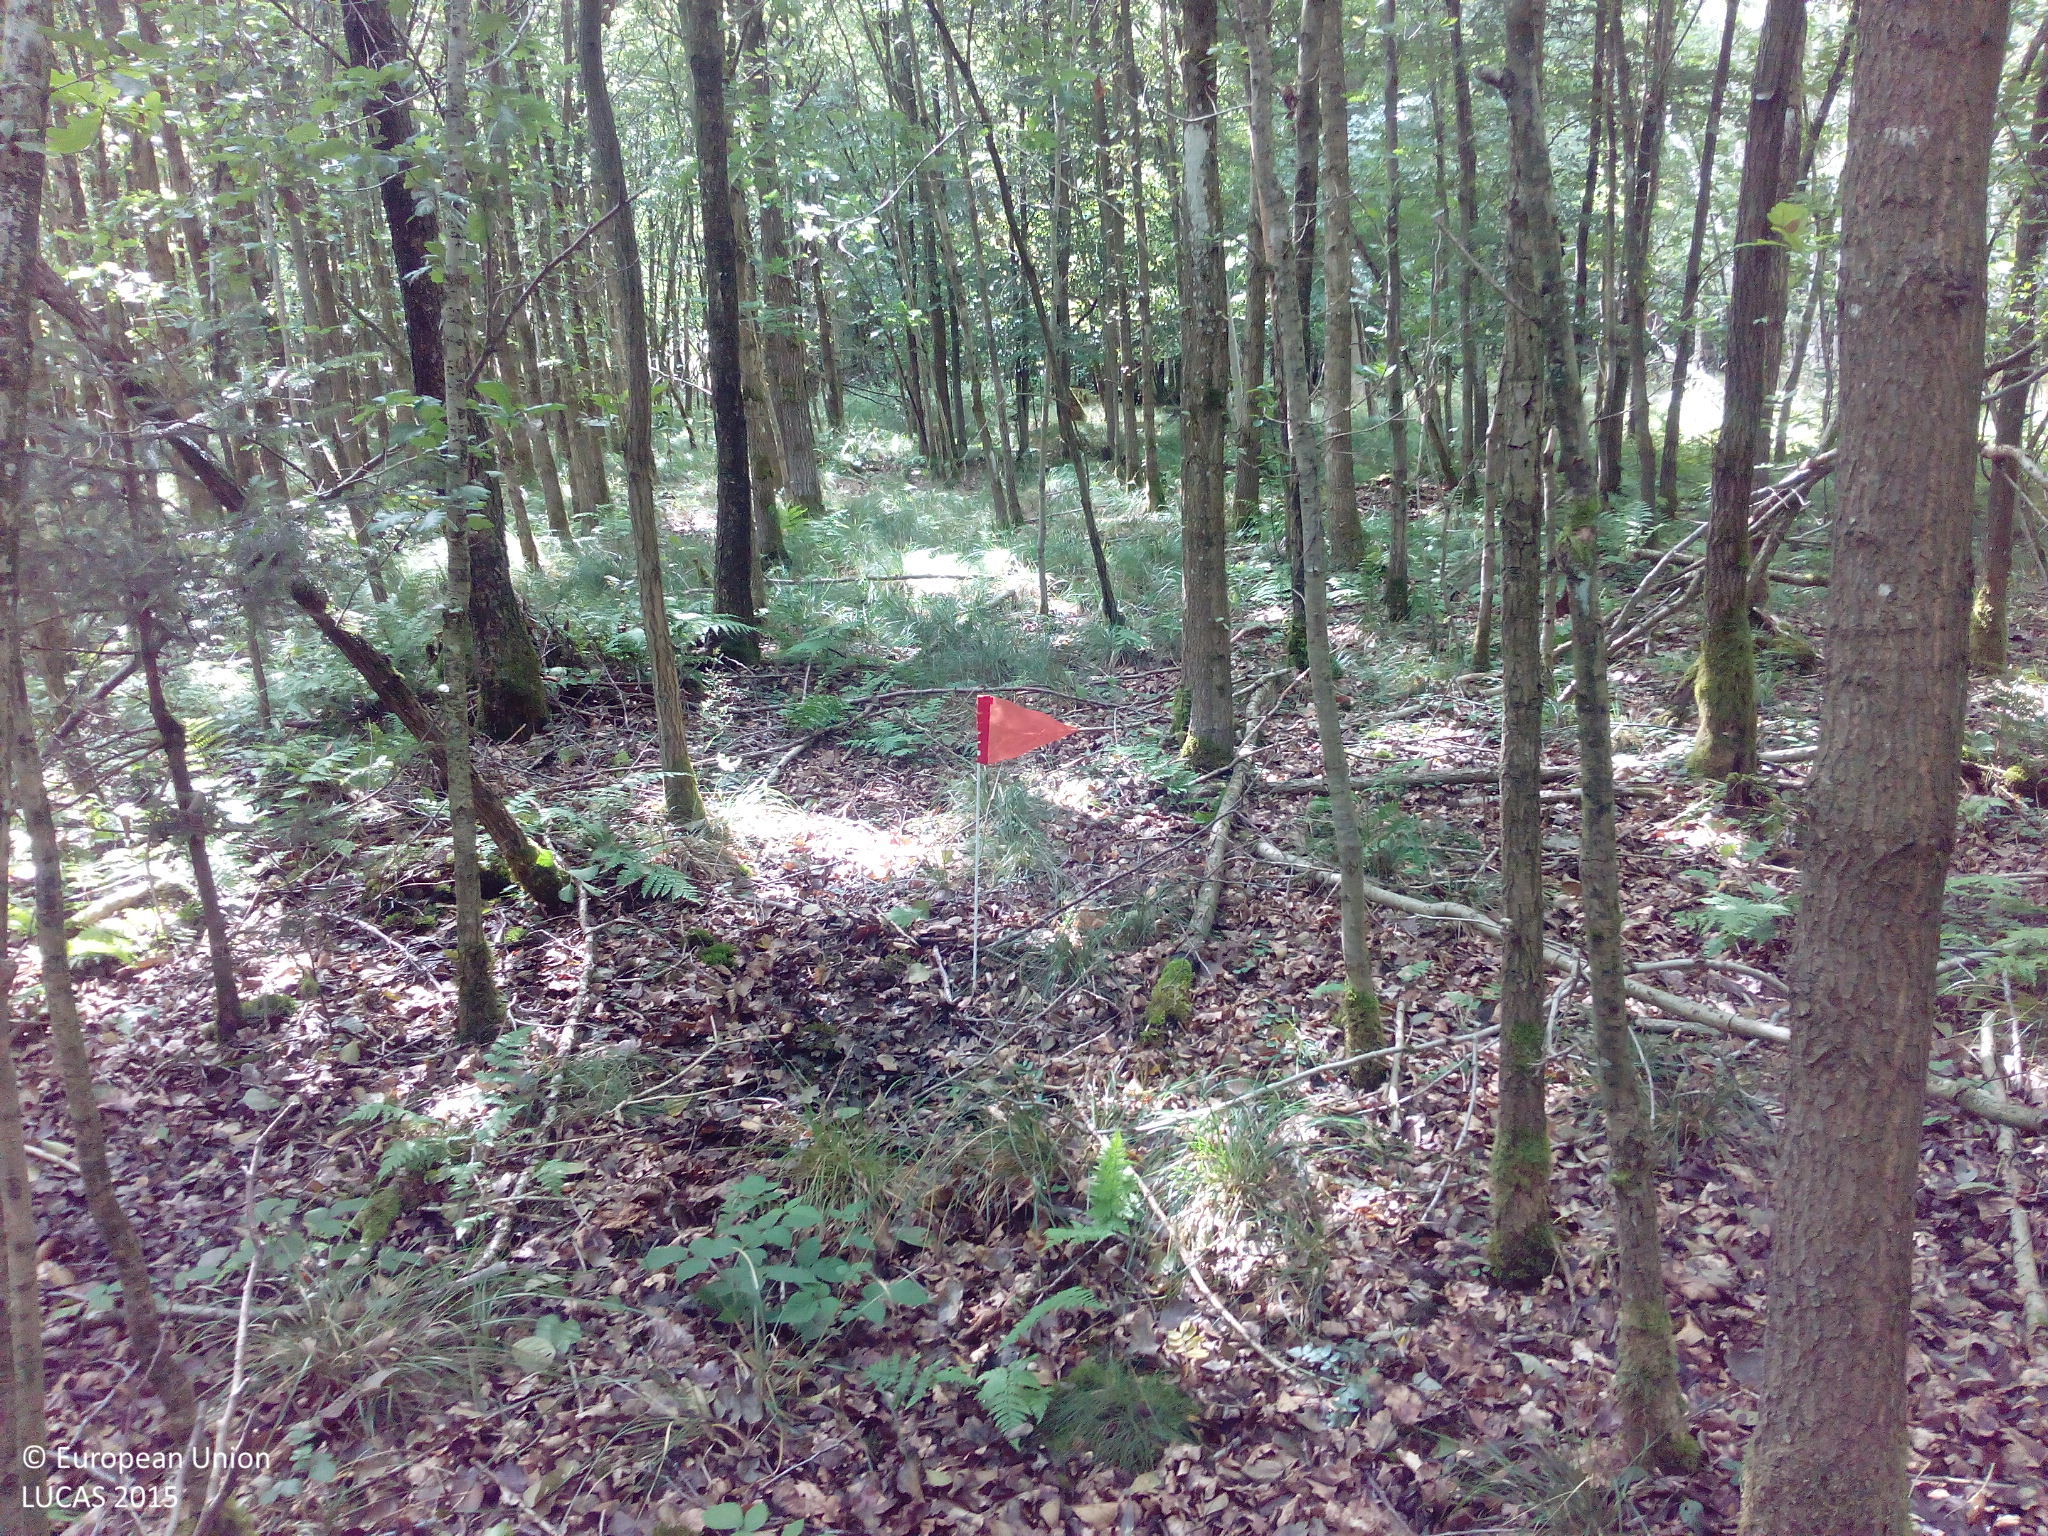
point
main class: Woodland
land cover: Broadleaved woodland
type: mesophytic deciduous forest
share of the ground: > 75 %
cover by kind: broadleaved forest trees 80 %, coniferous forest trees 5 %, herbaceous plants 5 %, lichens and mosses 5 %, unconsolidated bare surface 5 %
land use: Forestry
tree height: > 5 m
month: August
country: DE
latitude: 50.0675
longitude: 7.5275
